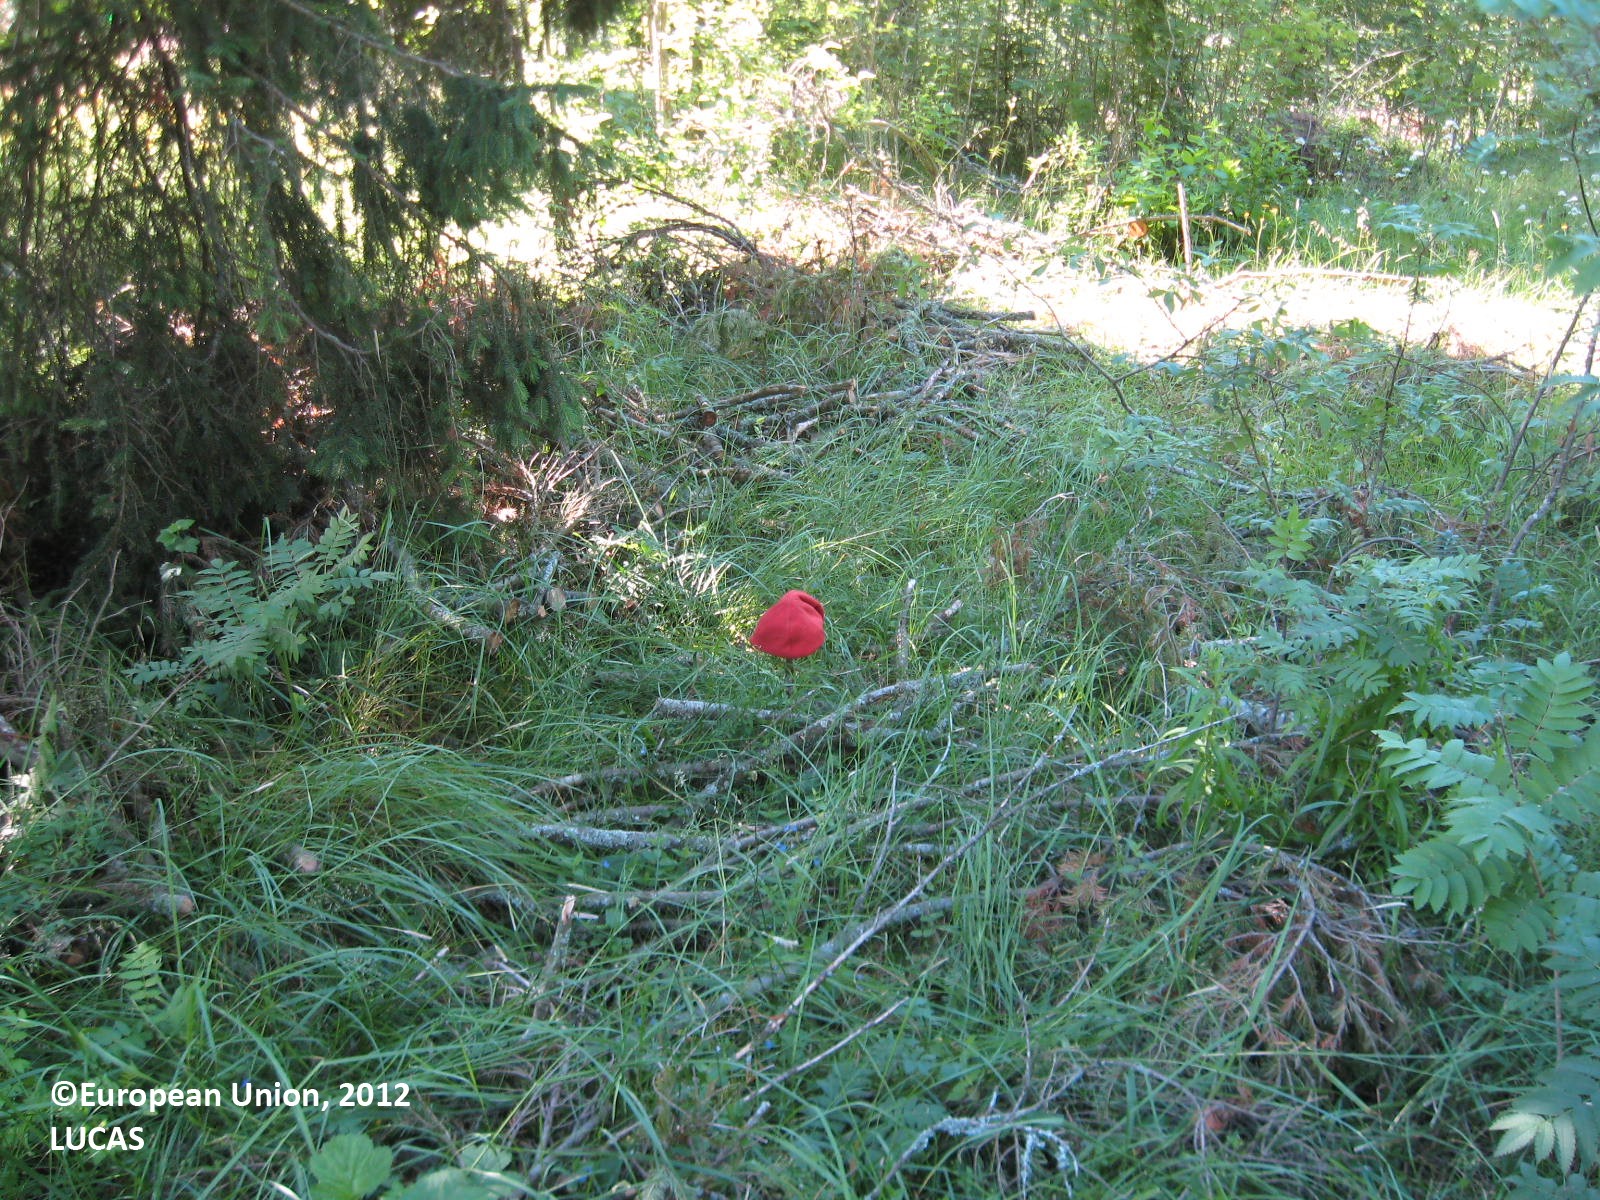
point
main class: Woodland
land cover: Other mixed woodland
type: boreal forest
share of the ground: > 75 %
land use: Community services
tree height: > 5 m
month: July
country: FI
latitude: 62.2700
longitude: 21.3906
